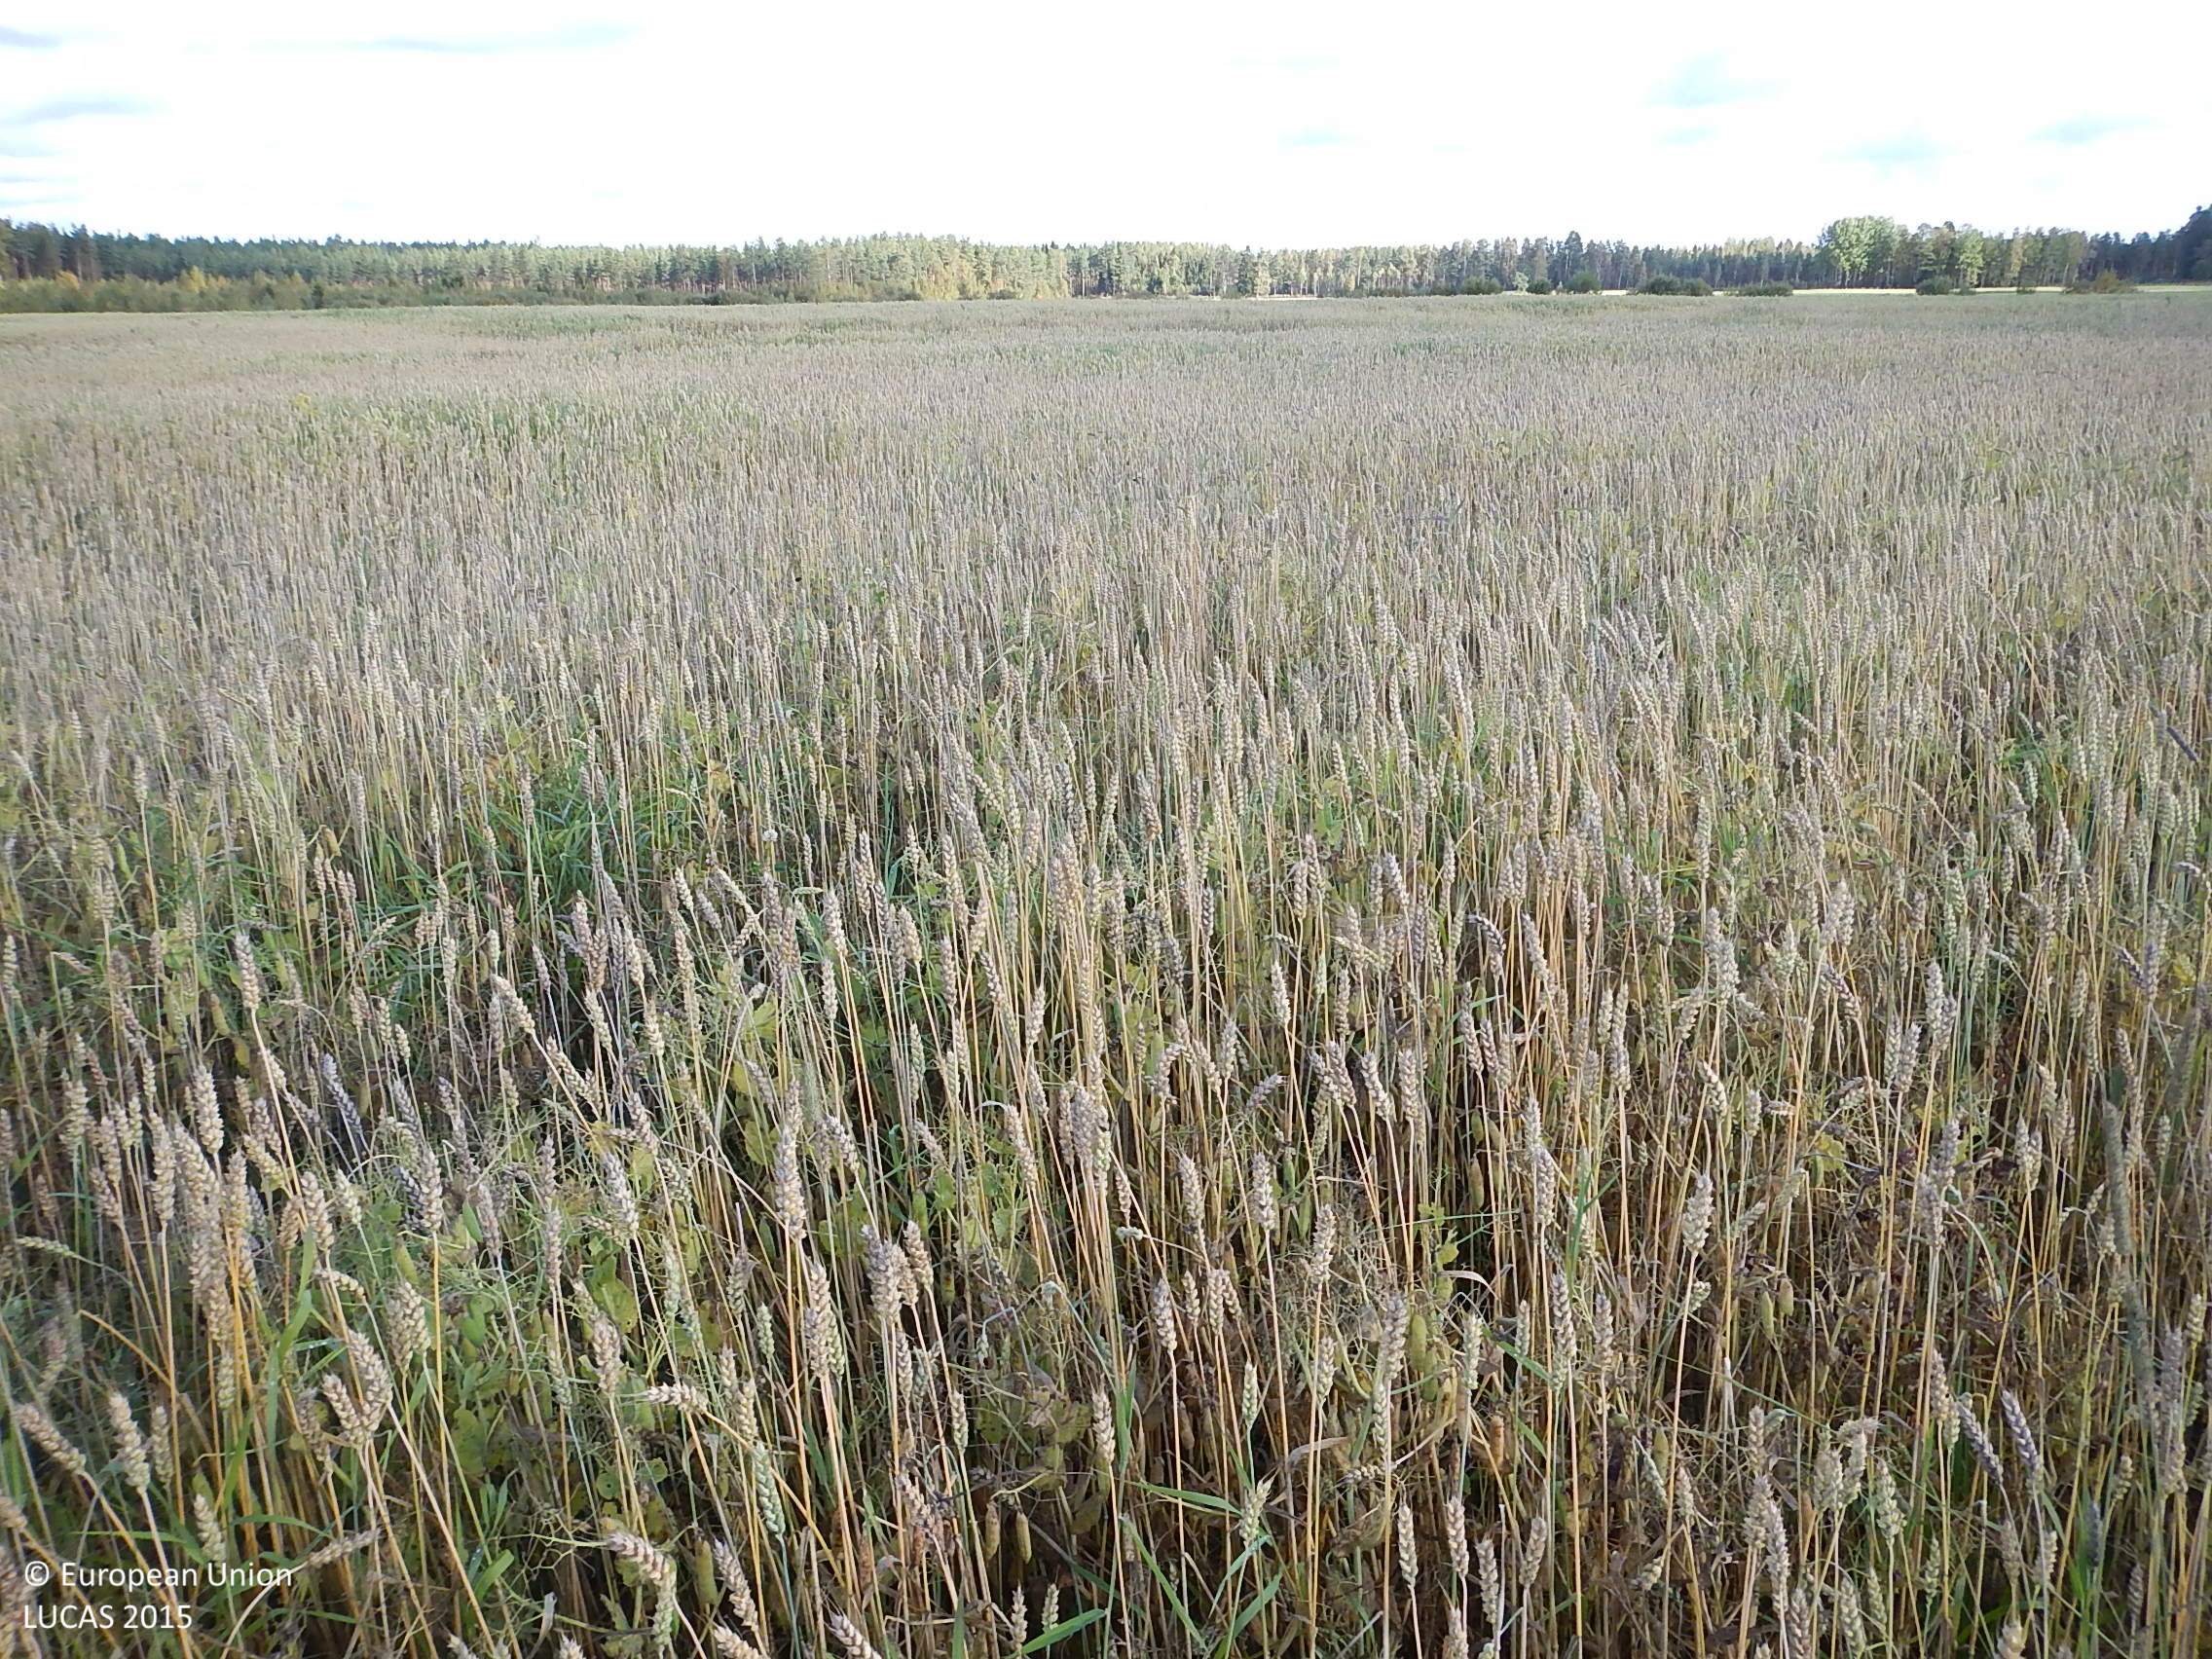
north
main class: Cropland
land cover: Common wheat
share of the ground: 50 - 75 %
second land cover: Dry pulses
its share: 25 - 50 %
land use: Agriculture (excluding fallow land and kitchen gardens)
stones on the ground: < 10 %
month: September
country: FI
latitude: 61.8122
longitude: 22.5295
